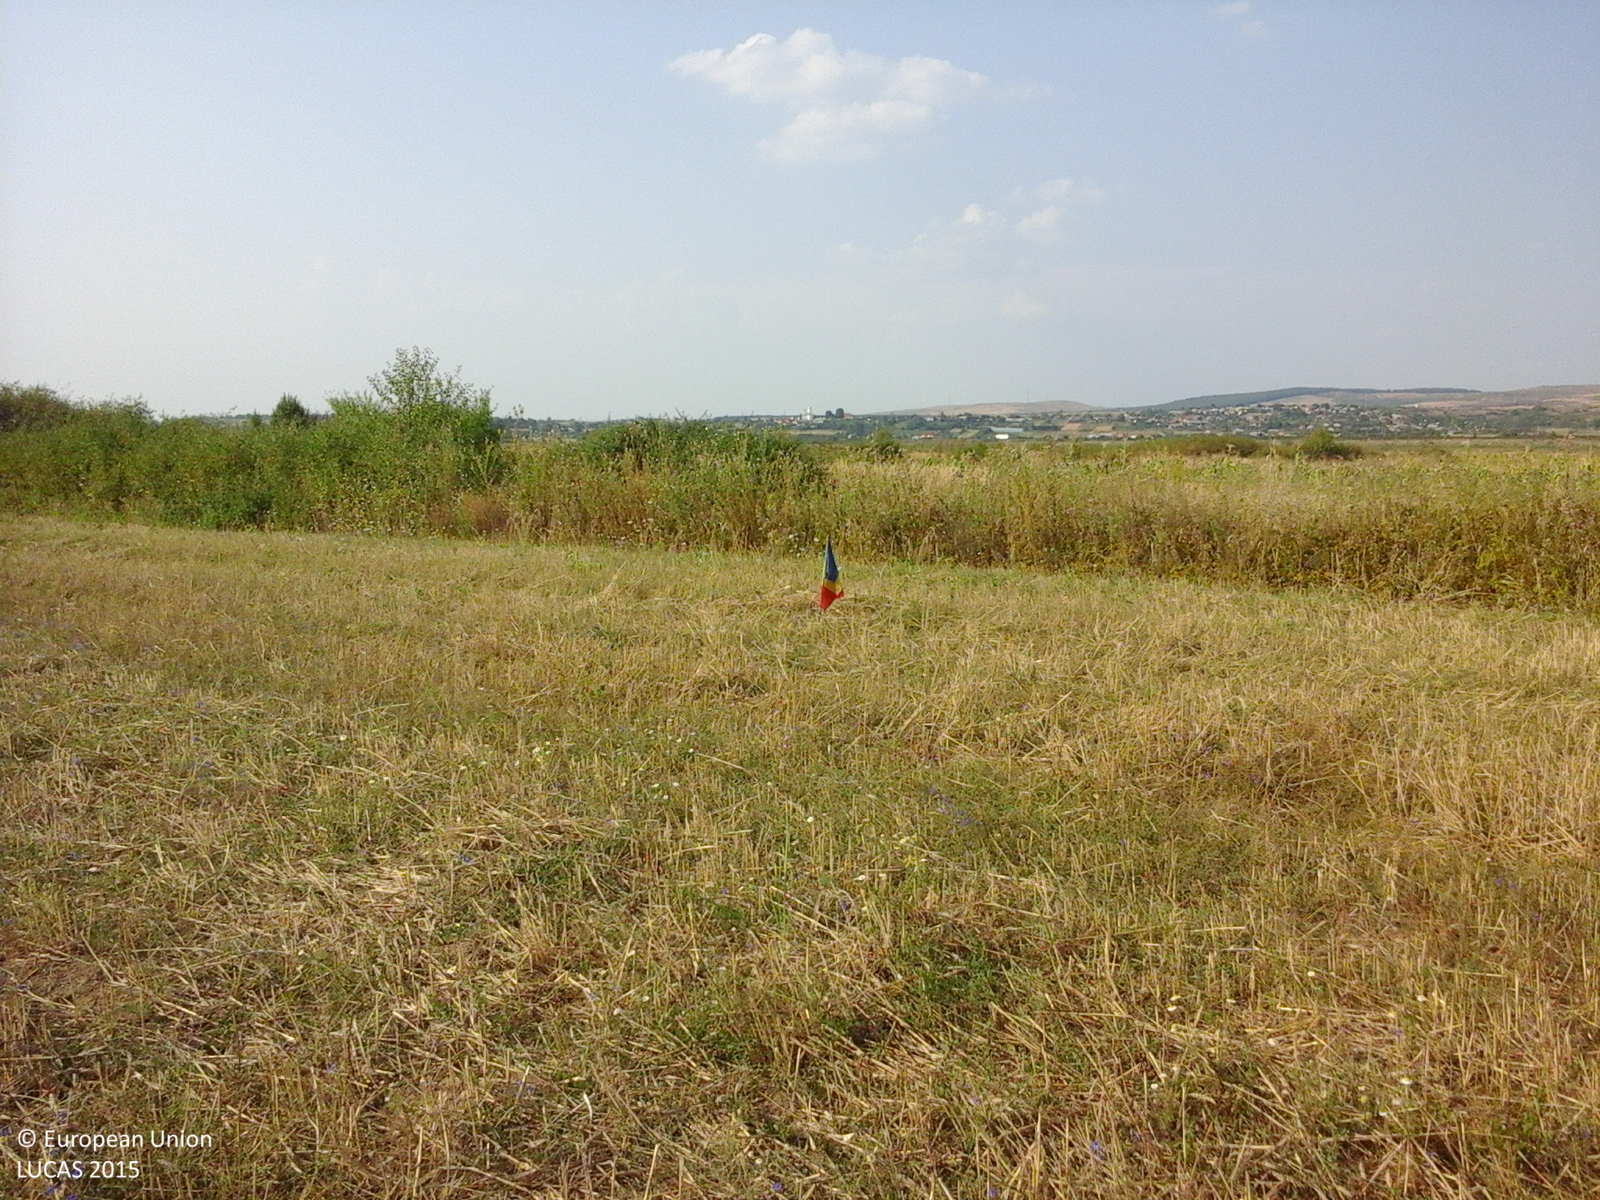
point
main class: Cropland
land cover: Common wheat
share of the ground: 50 - 75 %
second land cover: Spontaneously vegetated surfaces
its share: 25 - 50 %
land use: Agriculture (excluding fallow land and kitchen gardens)
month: August
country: RO
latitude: 44.5161
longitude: 23.5531
